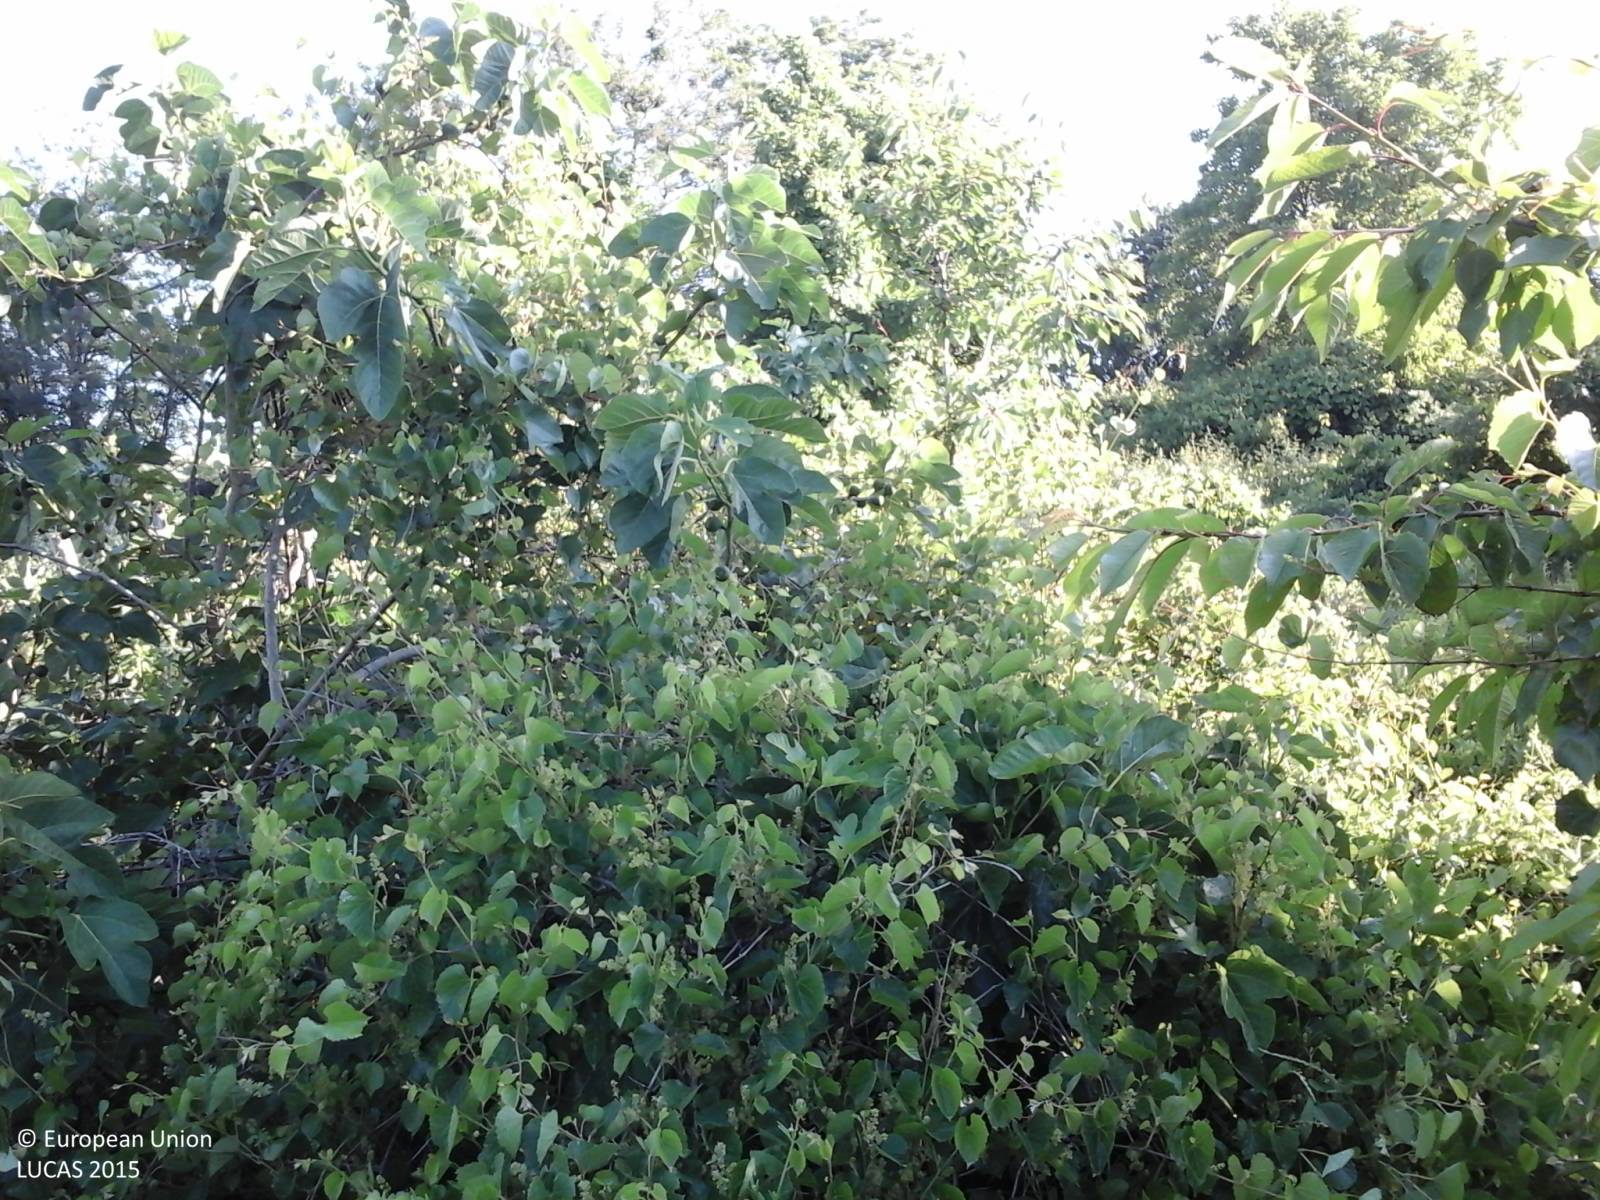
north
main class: Shrubland
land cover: Shrubland with sparse tree cover
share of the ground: > 75 %
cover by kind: shrubs 95 %, broadleaved forest trees 5 %
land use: Abandoned areas
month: June
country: IT
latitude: 42.0775
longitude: 13.7708
